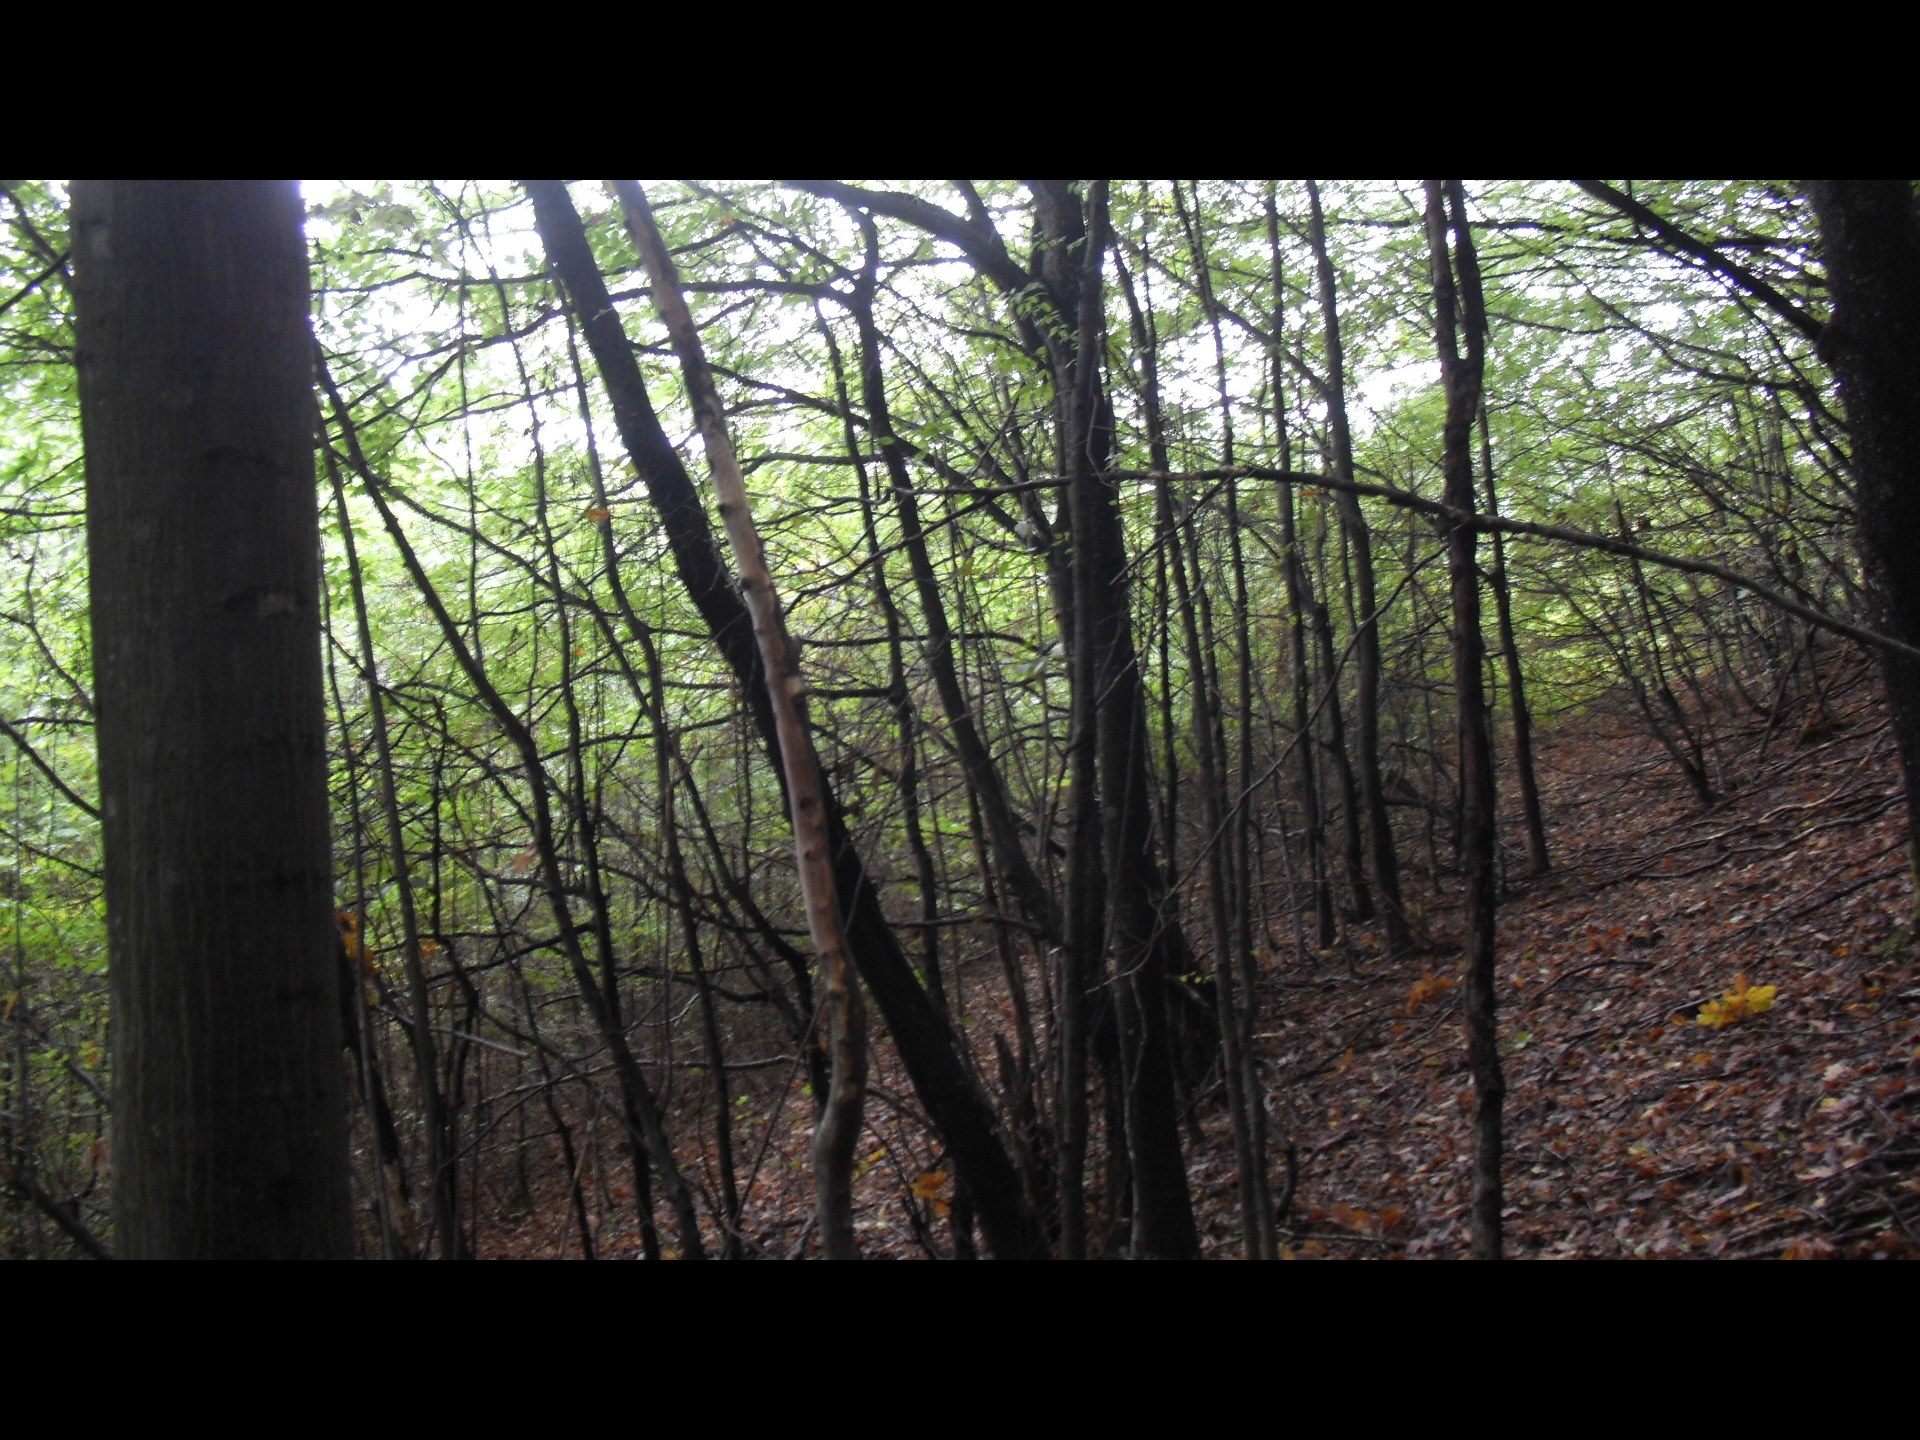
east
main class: Woodland
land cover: Broadleaved woodland
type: mesophytic deciduous forest
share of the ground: > 75 %
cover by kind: broadleaved forest trees 100 %
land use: Forestry
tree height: > 5 m
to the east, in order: Broadleaved woodland; Grassland with sparse tree/shrub cover; Broadleaved woodland; Grassland with sparse tree/shrub cover; Broadleaved woodland
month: October
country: BG
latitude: 43.4836
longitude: 22.7814
